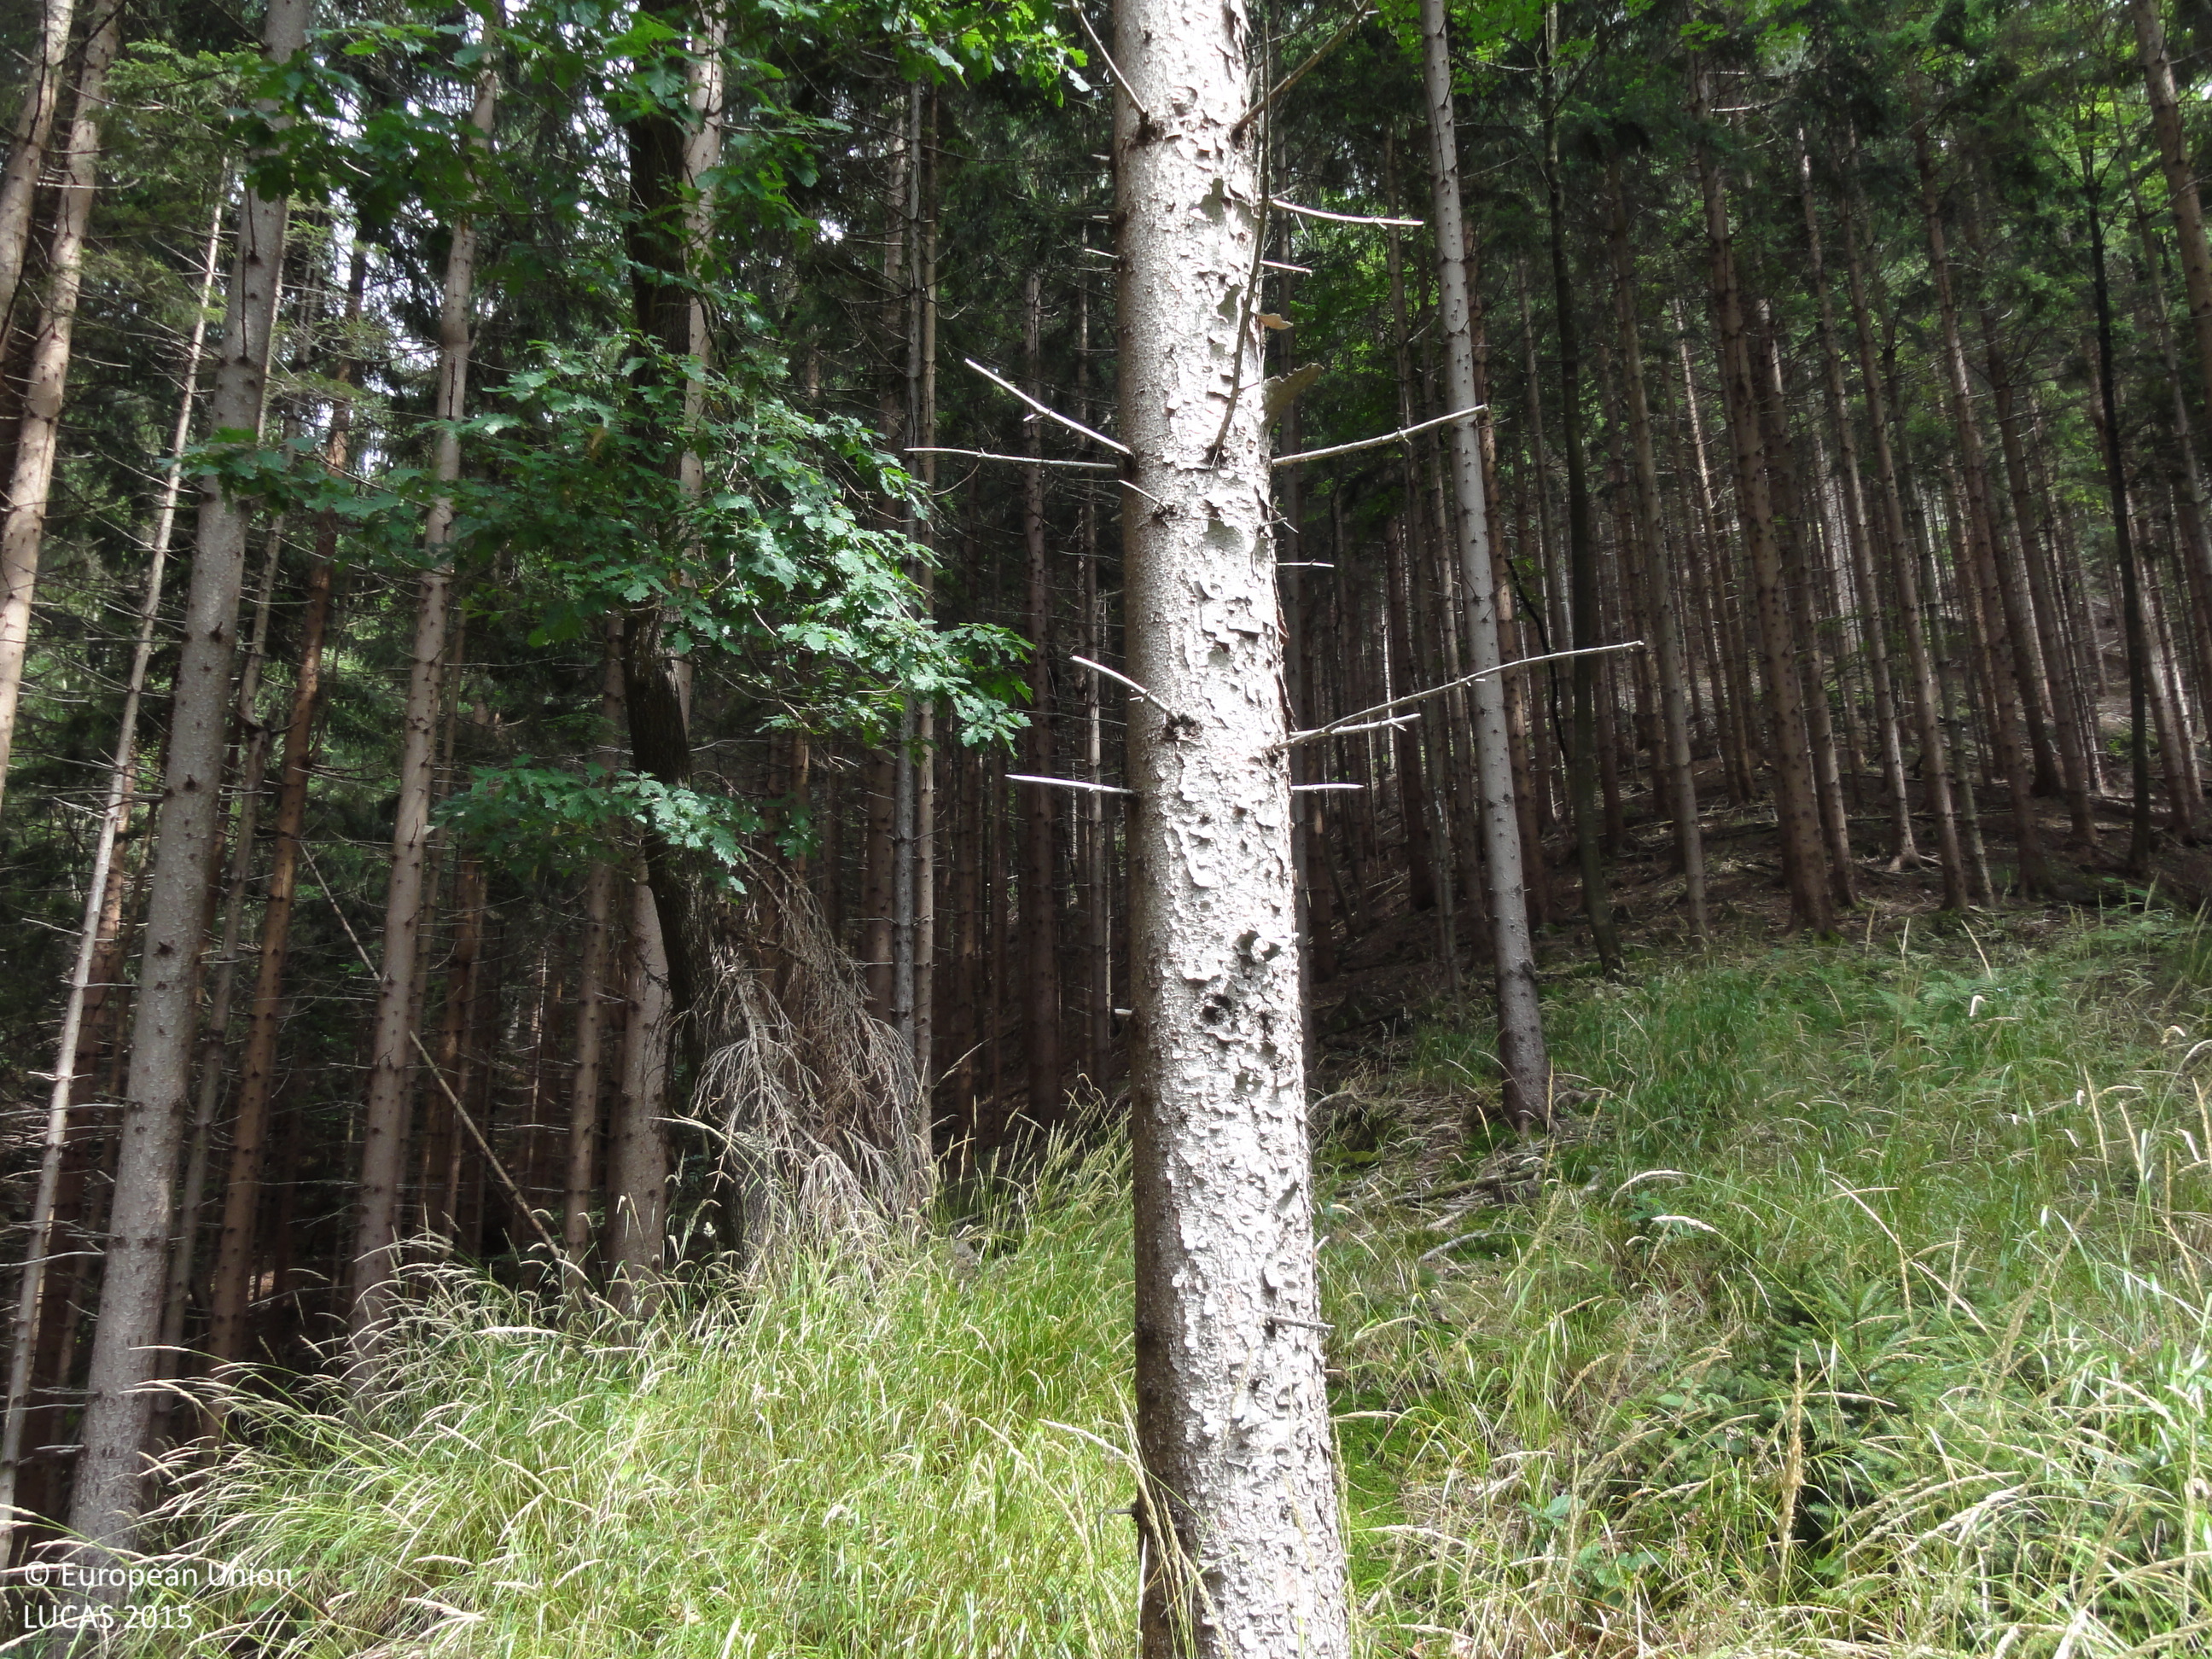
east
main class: Woodland
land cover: Spruce dominated coniferous woodland
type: hemiboreal forest and nemoral coniferous forest and mixed broadleaved-coniferous forest
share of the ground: > 75 %
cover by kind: coniferous forest trees 100 %
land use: Forestry
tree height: > 5 m
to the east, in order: Spruce dominated coniferous woodland; Tracks; Spruce dominated coniferous woodland; Spruce dominated mixed woodland; Rivers and streams; Spruce dominated mixed woodland; Spruce dominated coniferous woodland; Tracks; Spruce dominated coniferous woodland; Spruce dominated mixed woodland
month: August
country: SI
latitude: 46.3329
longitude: 14.8168
